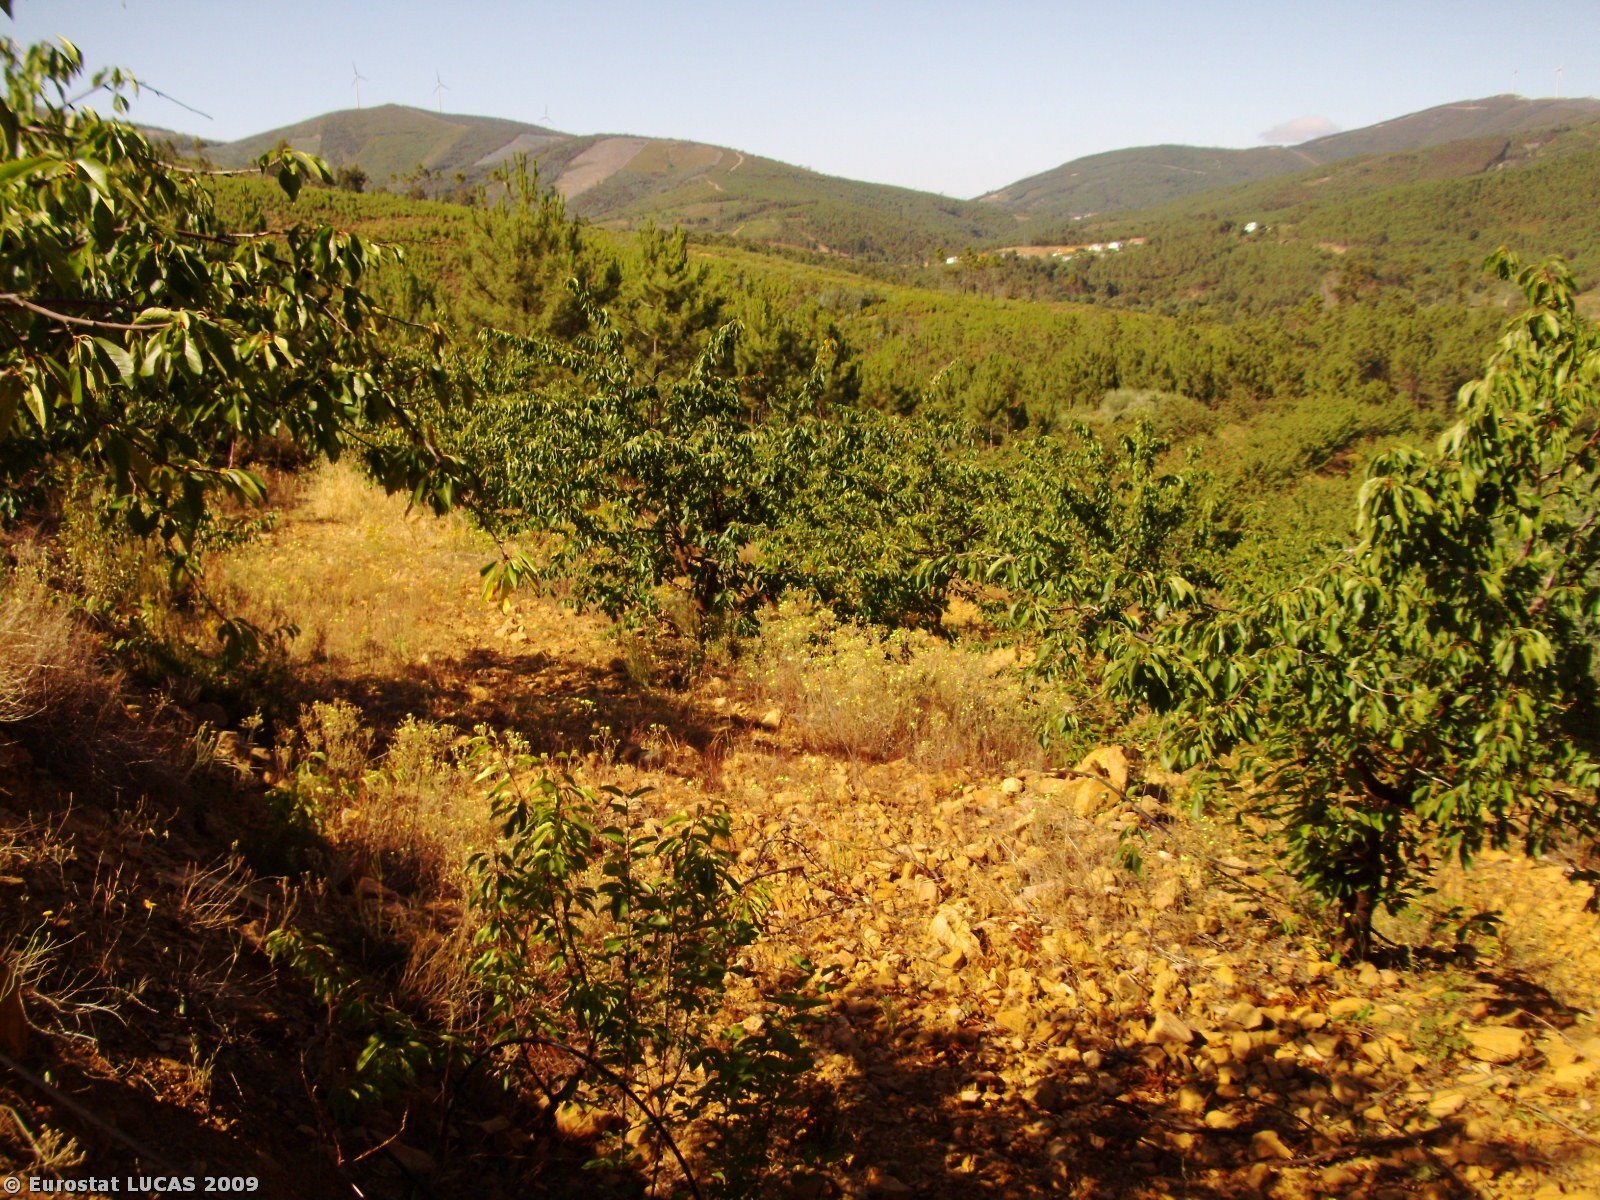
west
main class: Woodland
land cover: Coniferous woodland
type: coniferous forest of the mediterranean region
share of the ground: > 75 %
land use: Forestry
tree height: > 5 m
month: June
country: PT
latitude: 40.1110
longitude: -7.5515
